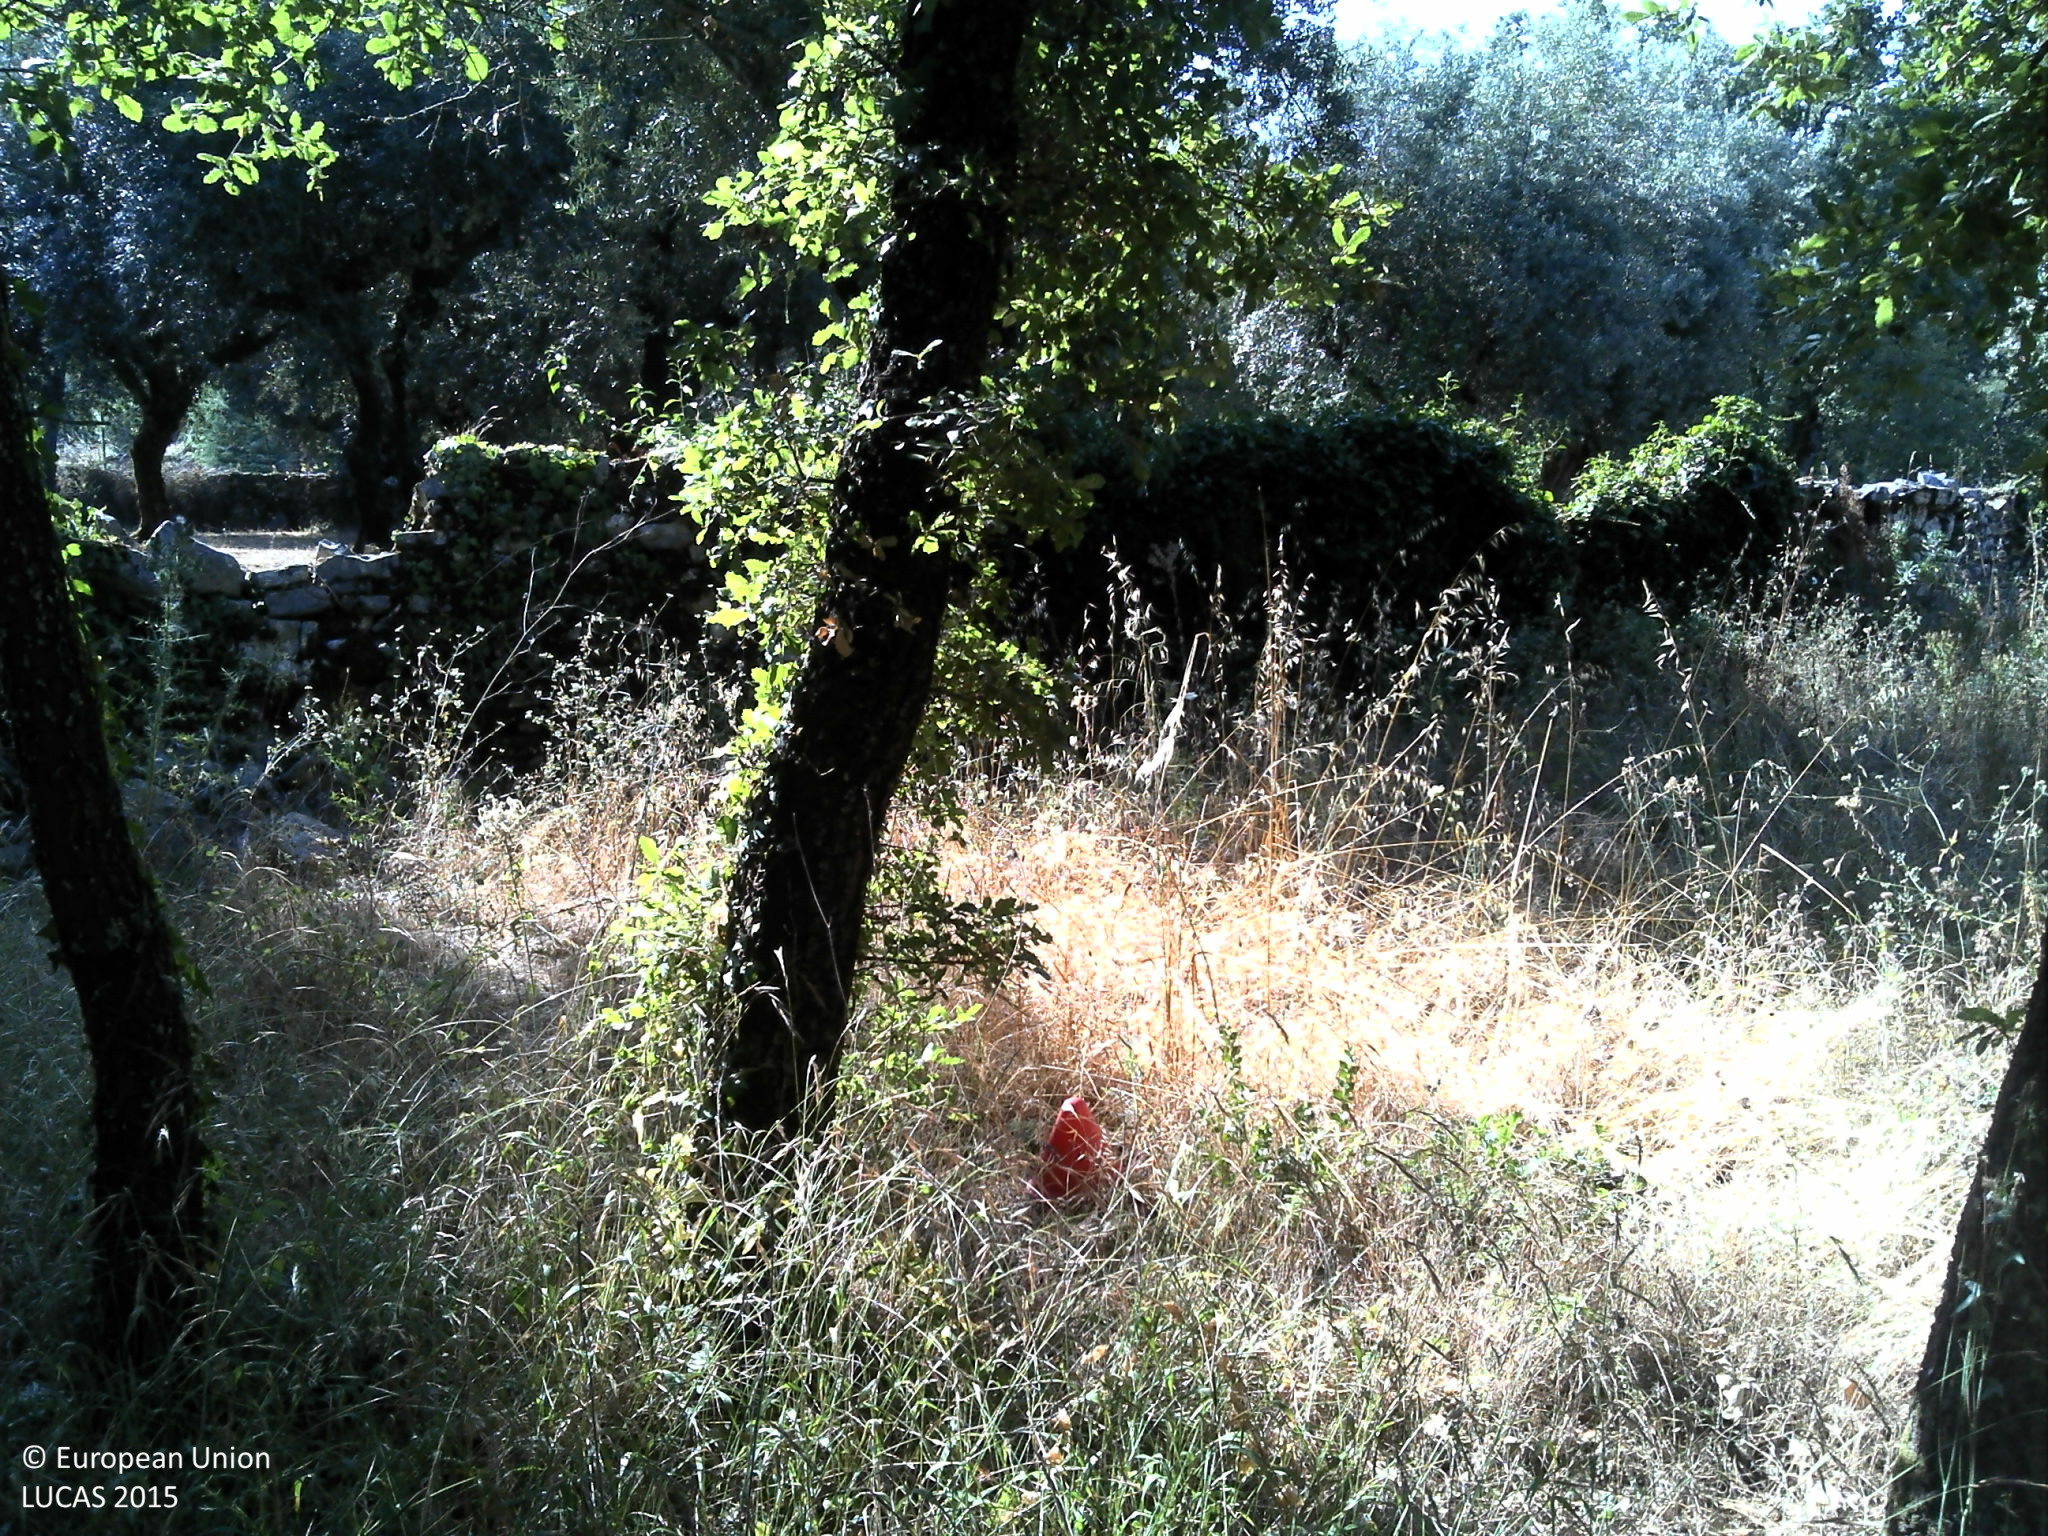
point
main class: Woodland
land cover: Broadleaved woodland
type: broadleaved evergreen forest
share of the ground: 10 - 25 %
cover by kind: herbaceous plants 80 %, broadleaved forest trees 20 %
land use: Forestry
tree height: > 5 m
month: July
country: PT
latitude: 39.9053
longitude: -8.4550
